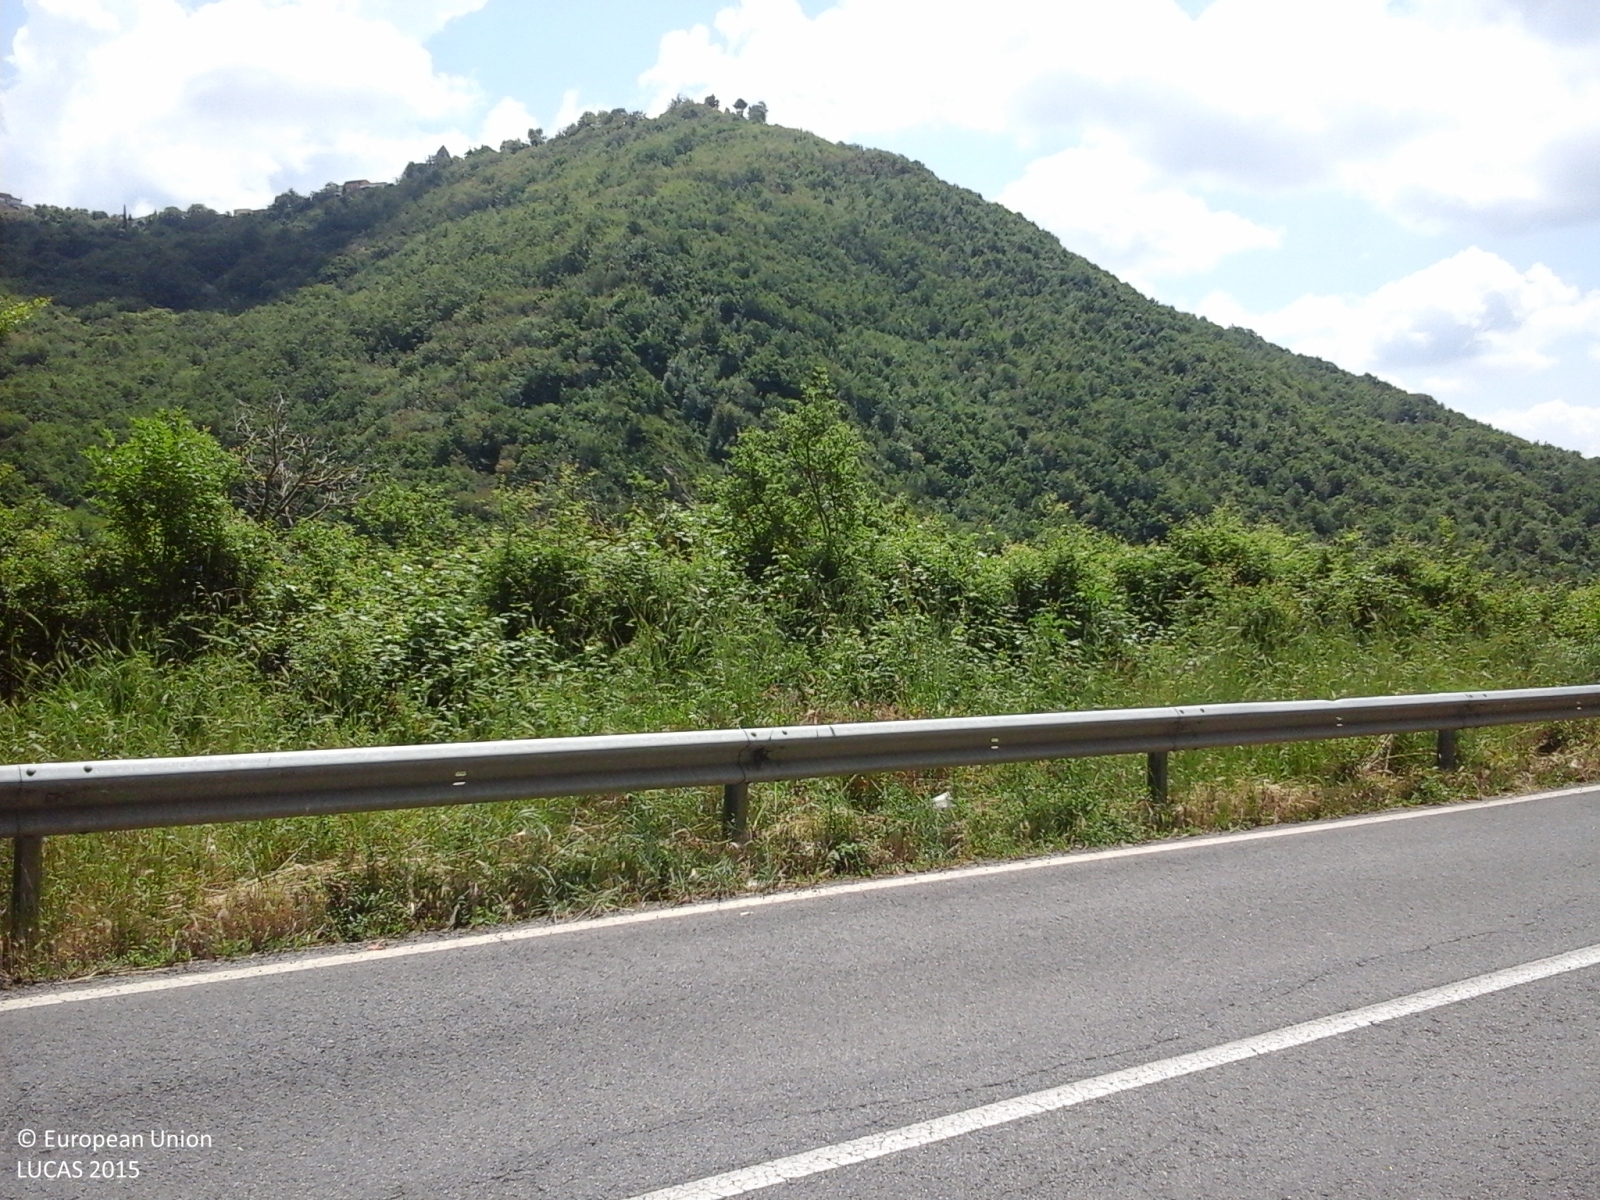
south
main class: Shrubland
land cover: Shrubland with sparse tree cover
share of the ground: > 75 %
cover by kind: shrubs 75 %, herbaceous plants 20 %, coniferous forest trees 5 %
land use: Semi-natural and natural areas not in use
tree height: > 5 m
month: May
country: IT
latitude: 41.2365
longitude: 15.1716
